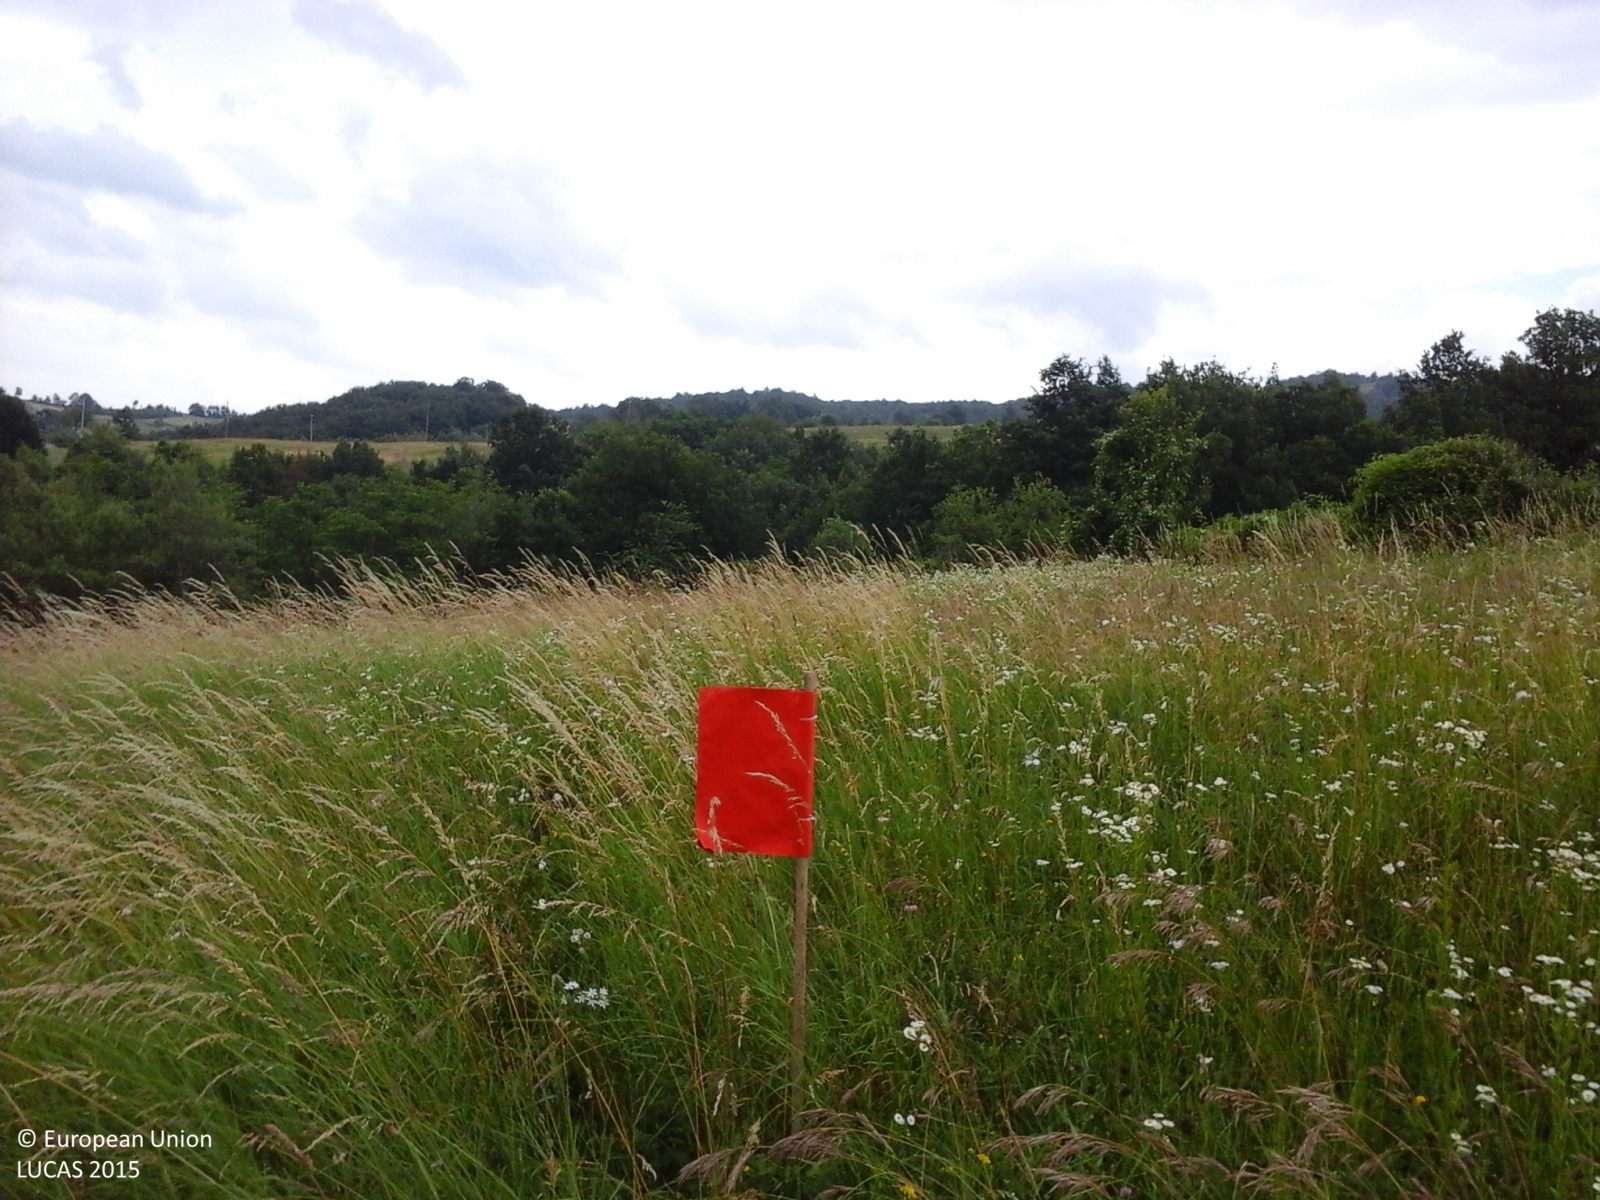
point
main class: Grassland
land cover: Grassland without tree/shrub cover
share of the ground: > 75 %
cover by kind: herbaceous plants 100 %
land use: Agriculture (excluding fallow land and kitchen gardens)
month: June
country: IT
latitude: 44.8188
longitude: 9.6340
